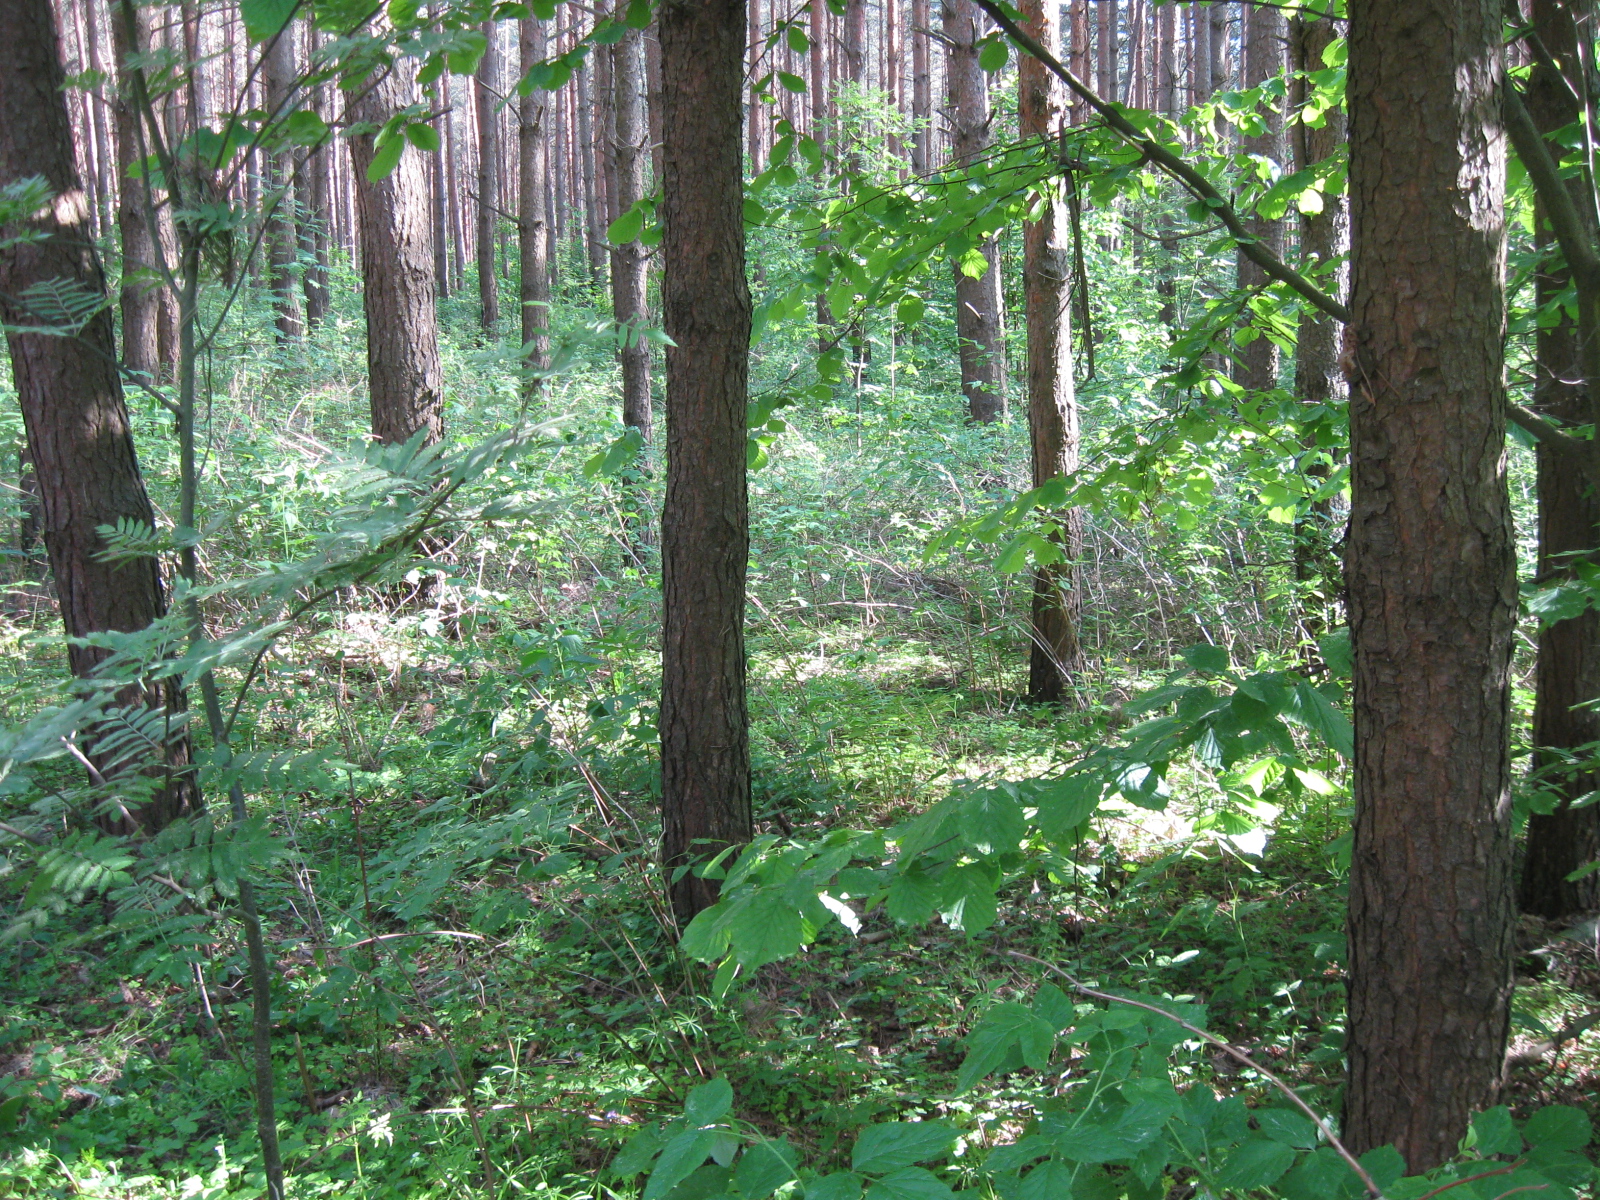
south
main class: Woodland
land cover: Pine dominated coniferous woodland
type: hemiboreal forest and nemoral coniferous forest and mixed broadleaved-coniferous forest
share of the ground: > 75 %
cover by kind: coniferous forest trees 90 %, broadleaved forest trees 5 %, herbaceous plants 5 %
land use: Forestry
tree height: > 5 m
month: June
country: LT
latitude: 54.2750
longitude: 23.7396
